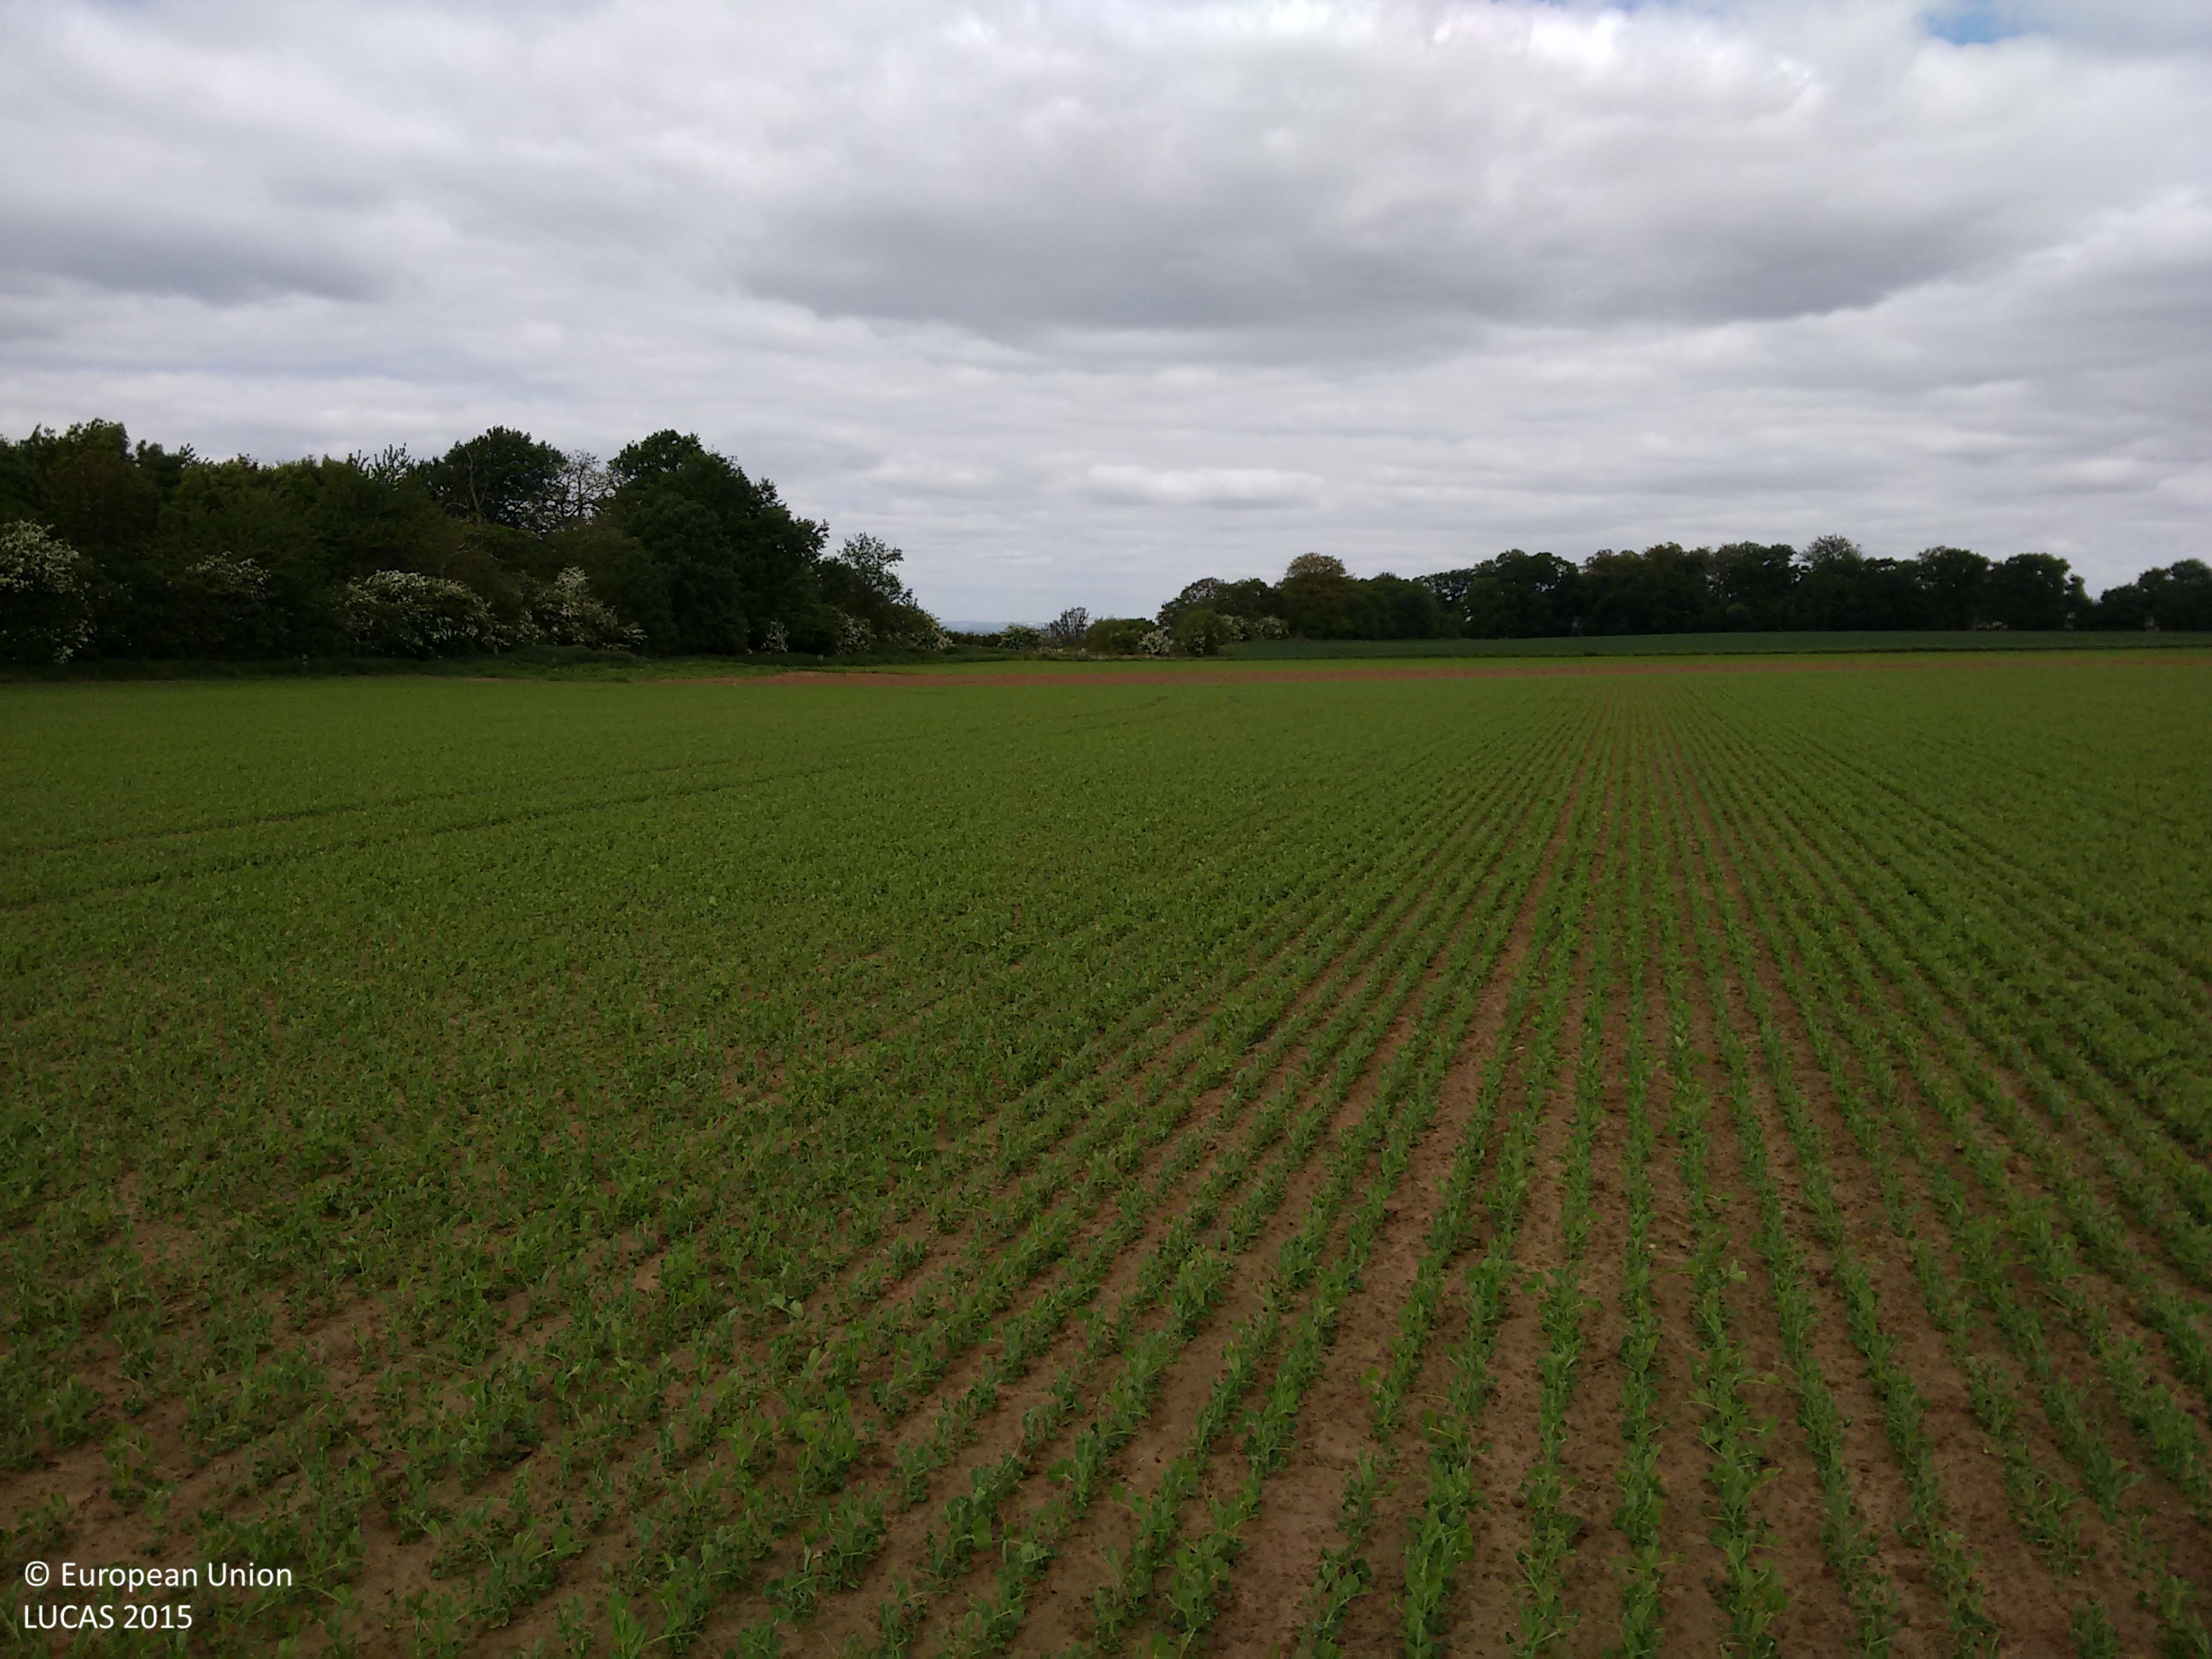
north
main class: Cropland
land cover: Dry pulses
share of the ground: 25 - 50 %
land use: Agriculture (excluding fallow land and kitchen gardens)
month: May
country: GB
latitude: 53.6720
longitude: -0.6803
